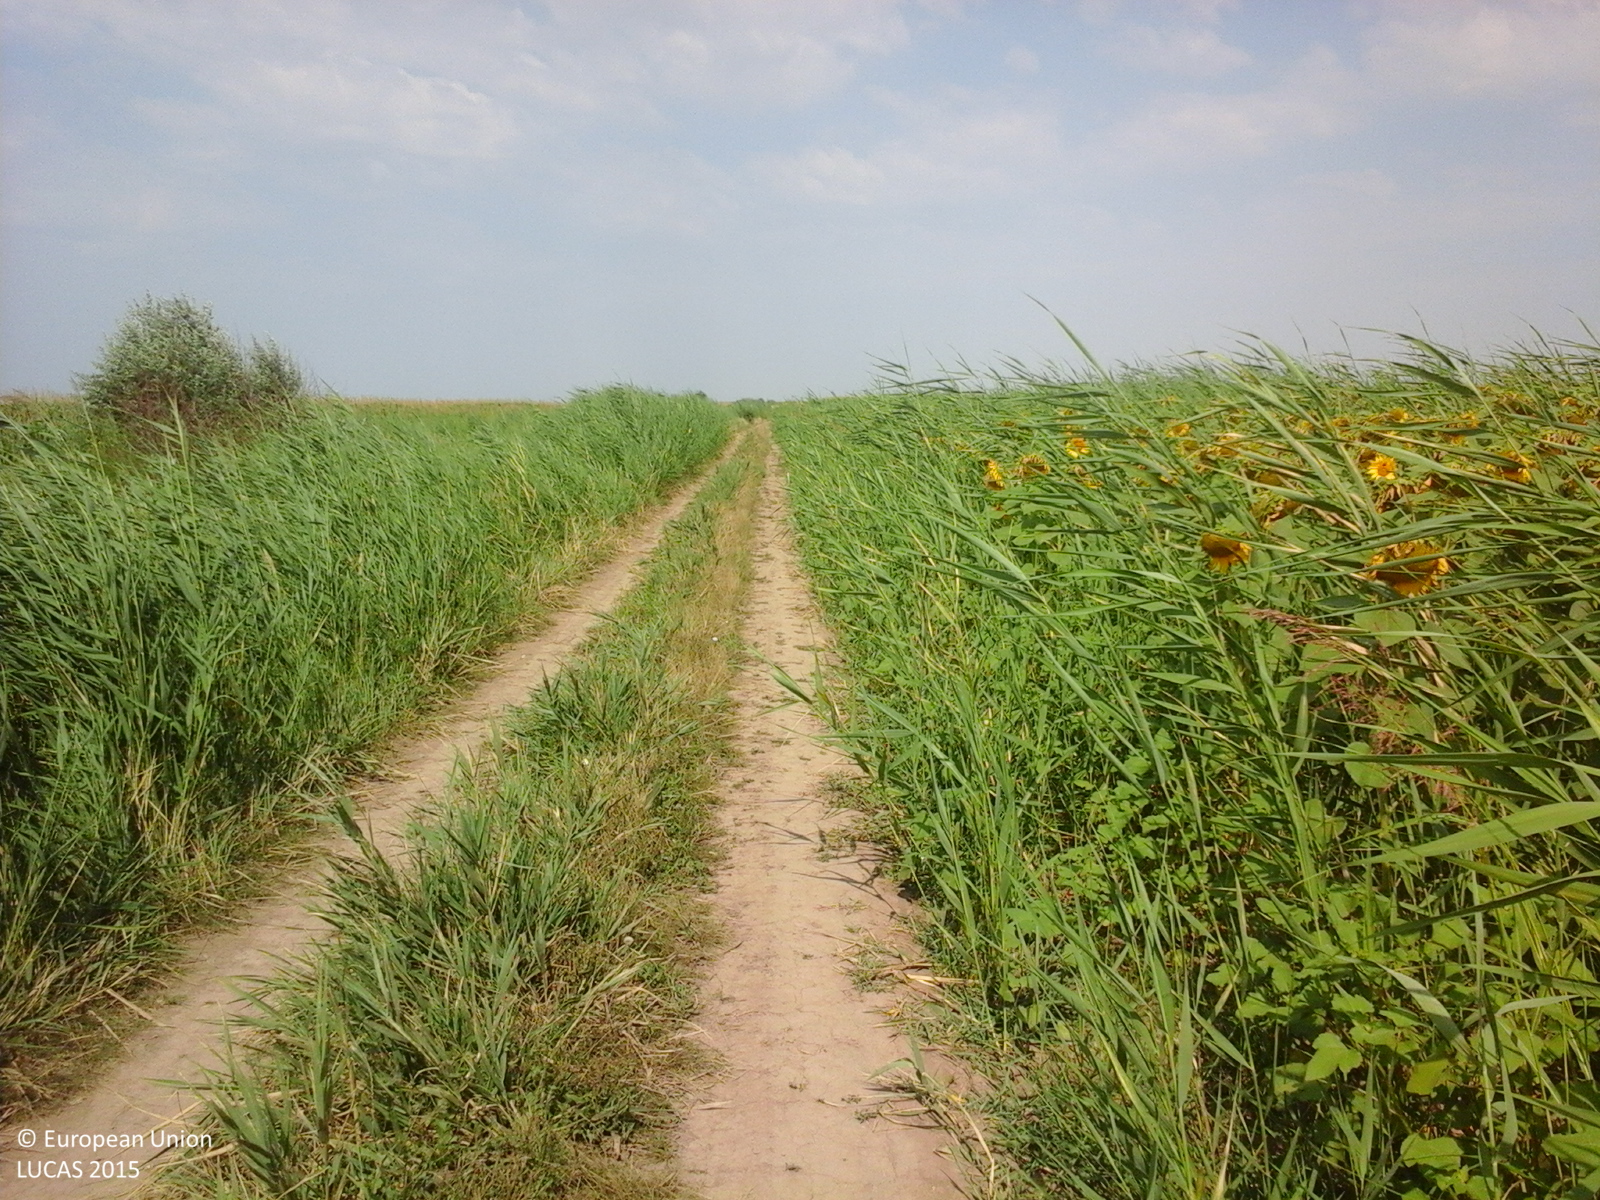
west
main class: Cropland
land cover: Sunflower
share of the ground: > 75 %
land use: Agriculture (excluding fallow land and kitchen gardens)
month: July
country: RO
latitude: 44.6813
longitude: 27.2321
